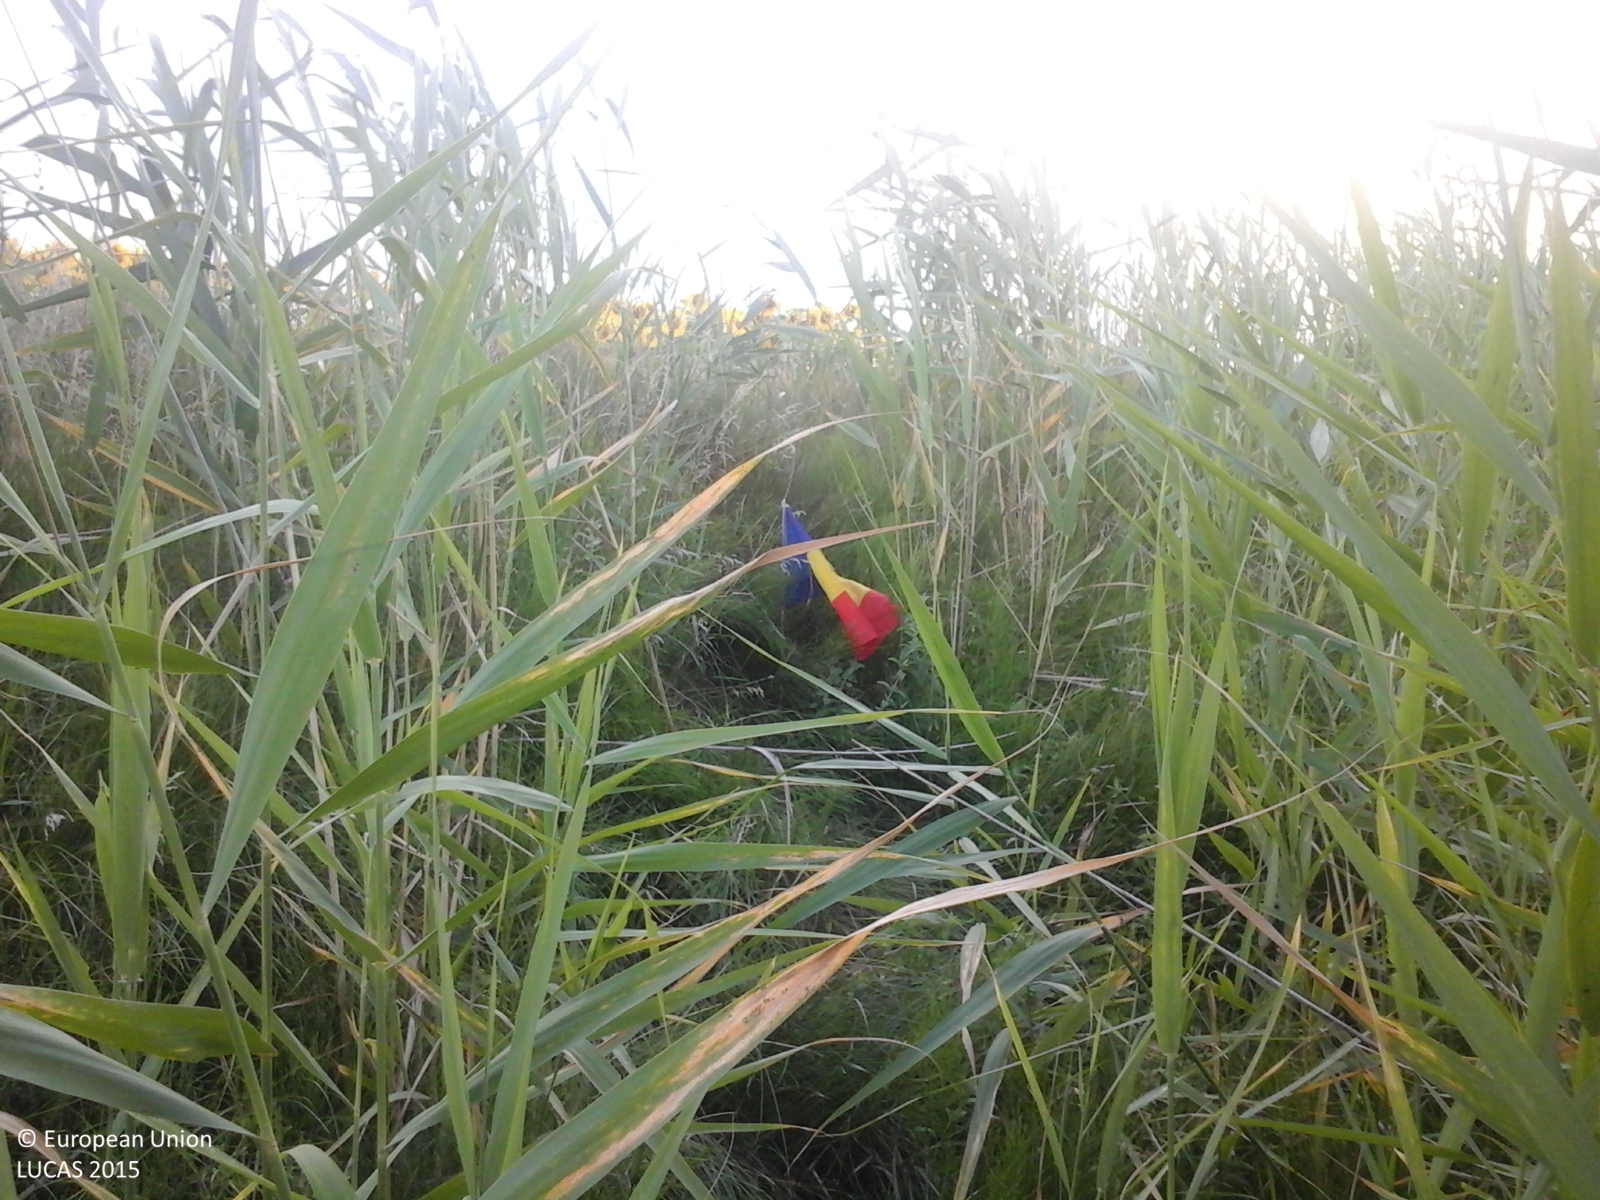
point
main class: Grassland
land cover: Spontaneously vegetated surfaces
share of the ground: 50 - 75 %
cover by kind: herbaceous plants 100 %
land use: Agriculture (excluding fallow land and kitchen gardens)
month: July
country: RO
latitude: 43.8484
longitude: 24.6847
